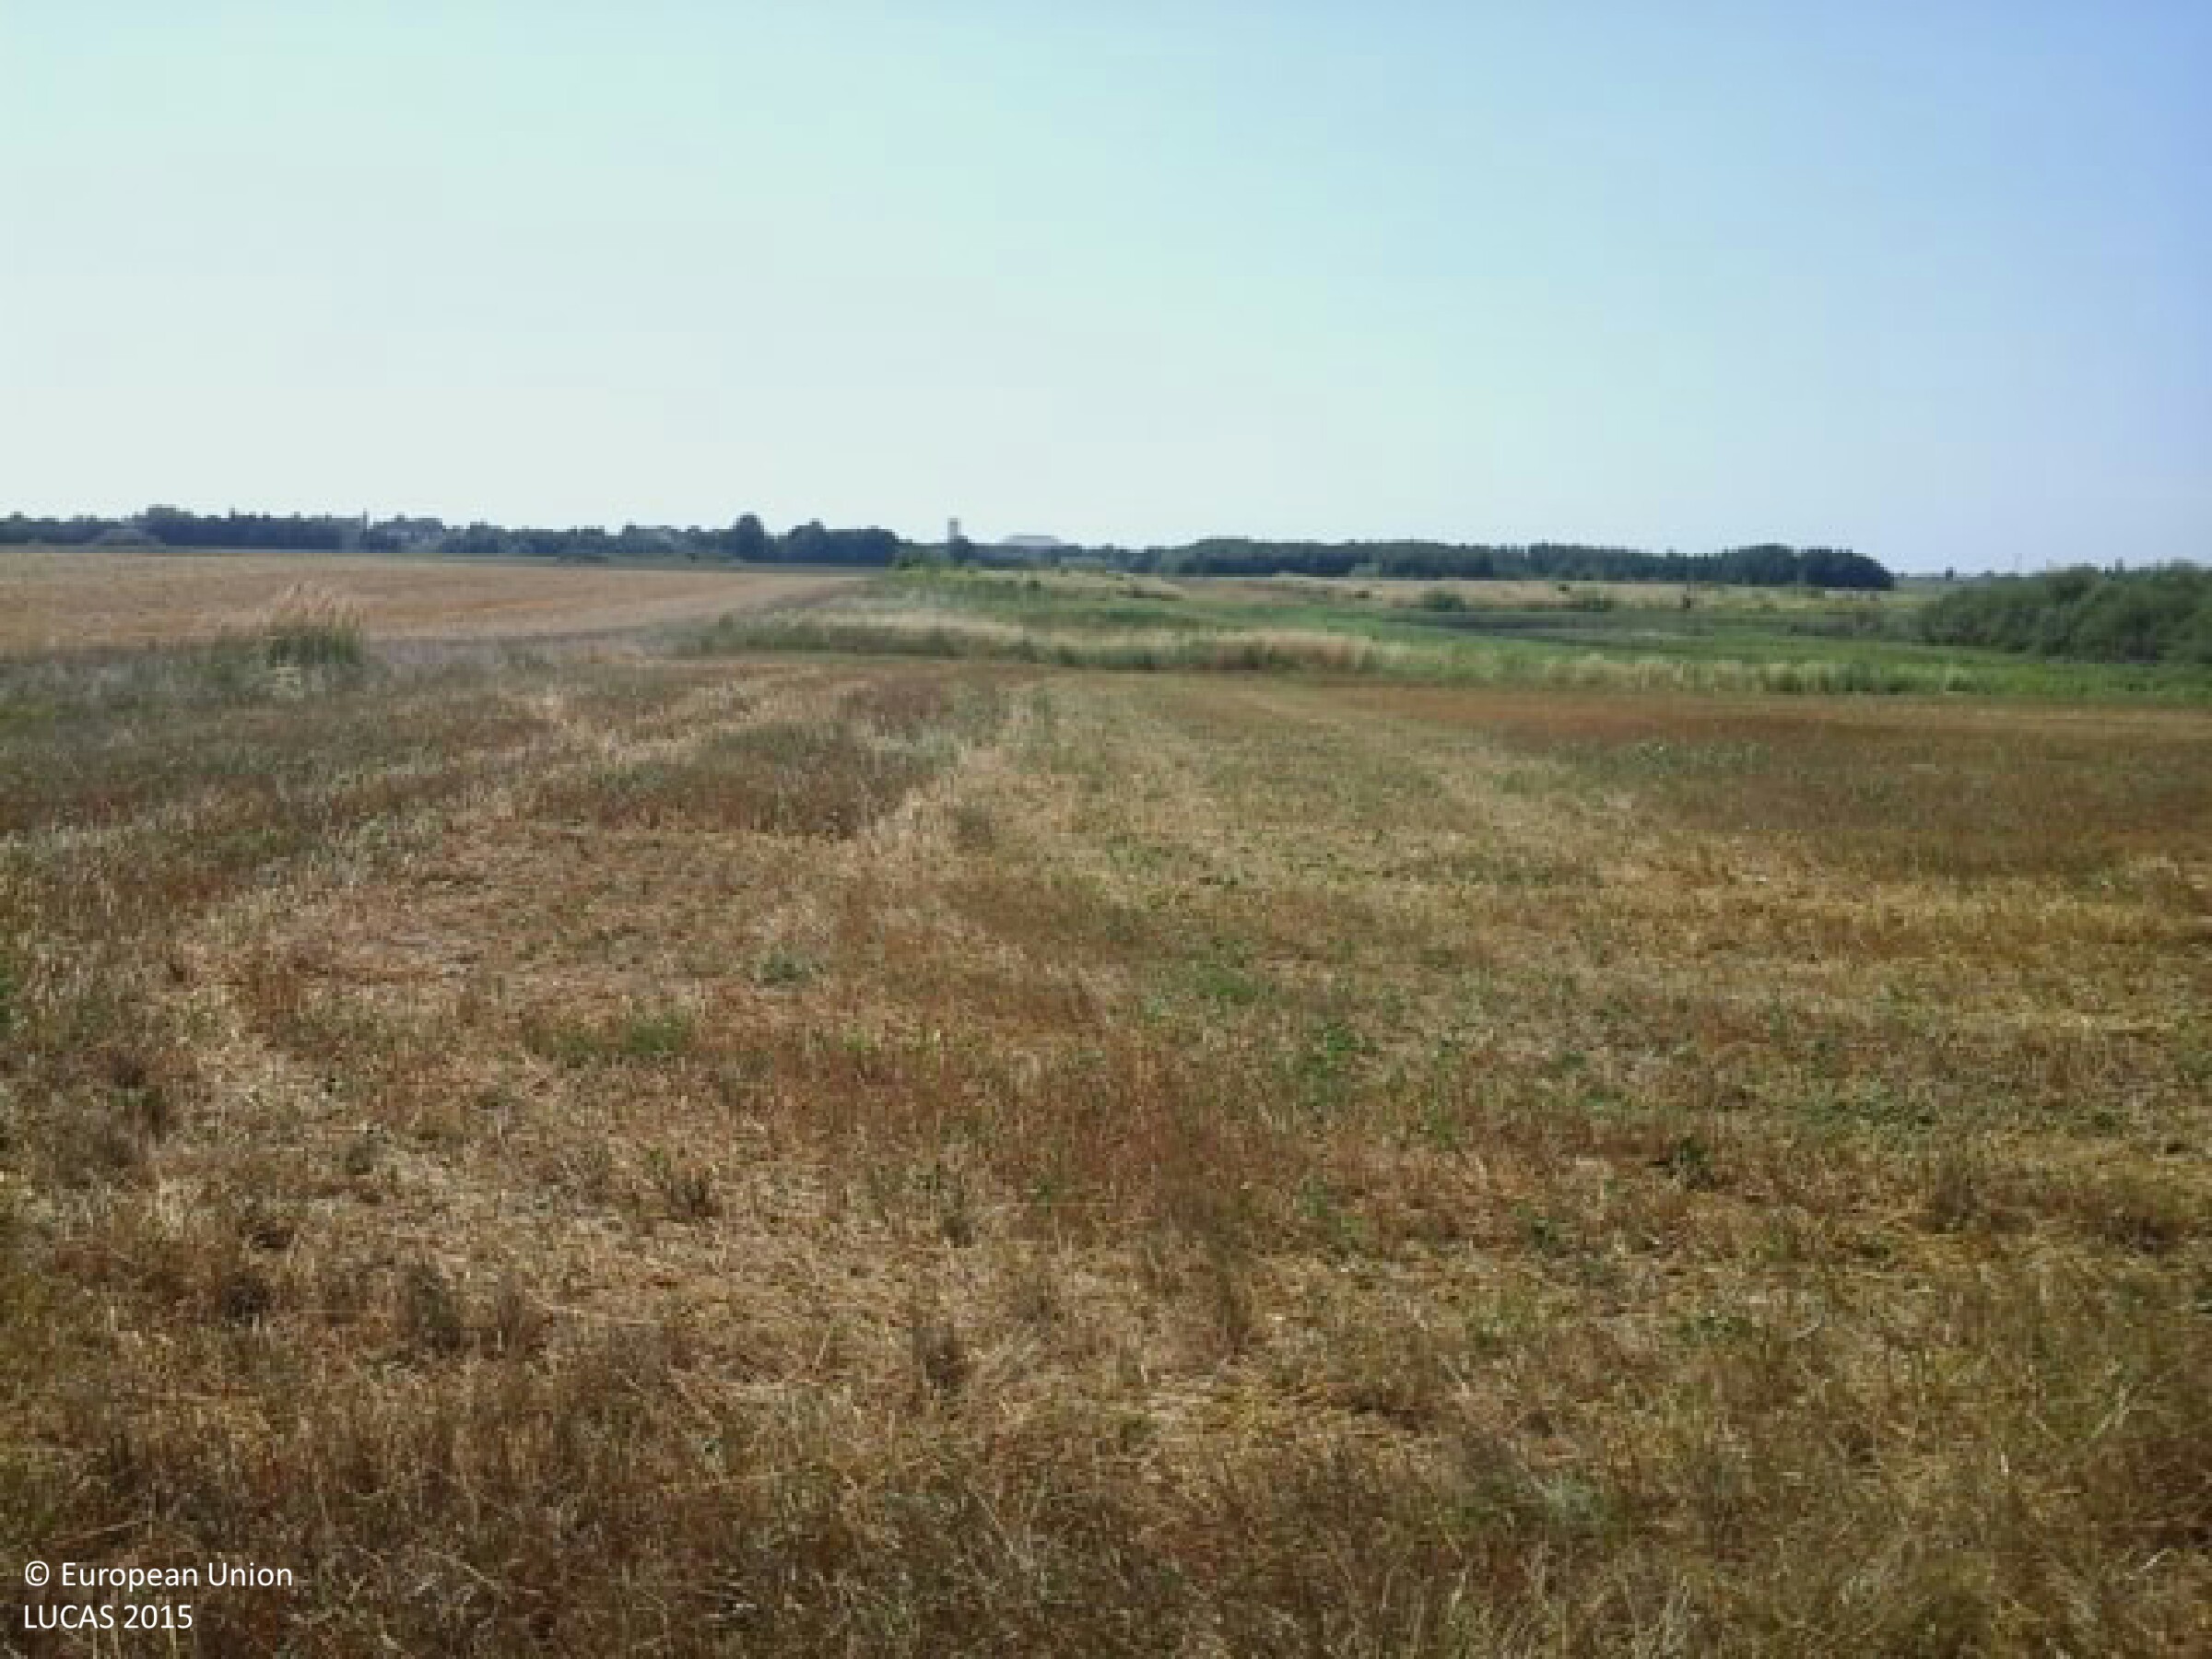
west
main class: Cropland
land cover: Common wheat
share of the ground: < 10 %
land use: Agriculture (excluding fallow land and kitchen gardens)
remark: Harvested field
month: July
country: HU
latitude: 46.2581
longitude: 17.1247
